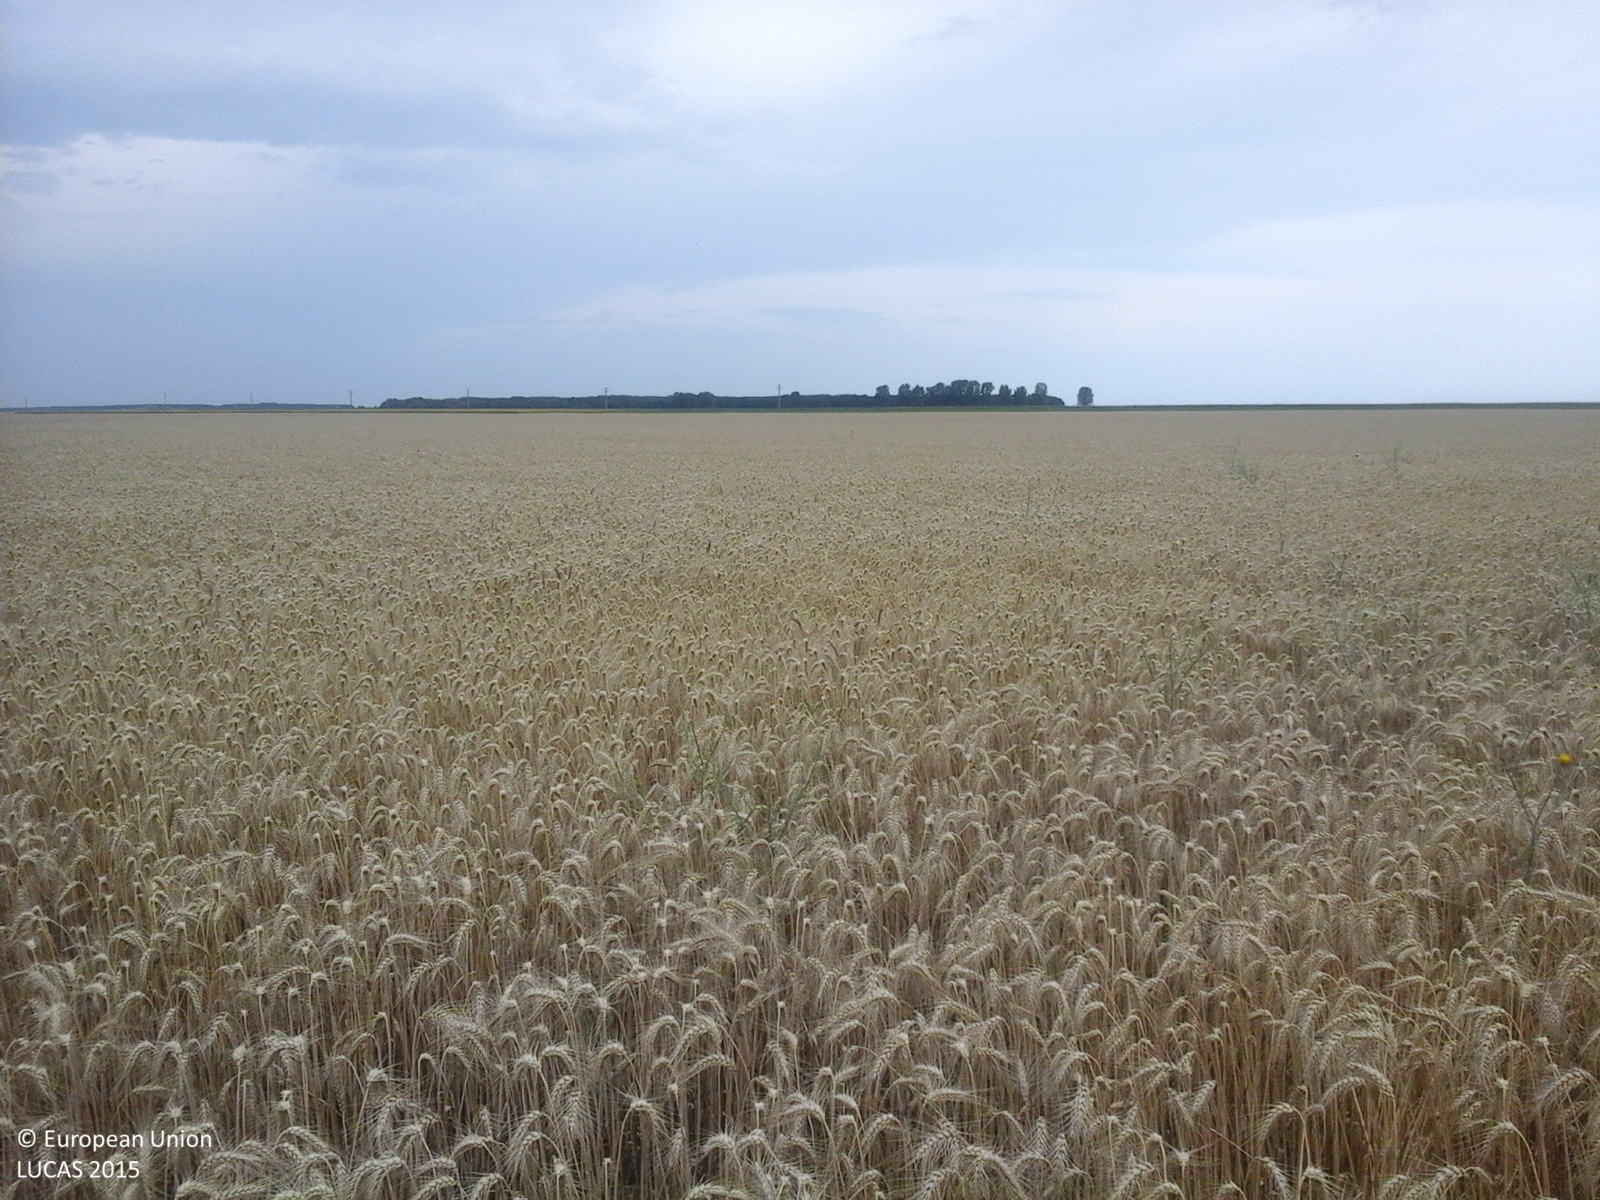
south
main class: Cropland
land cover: Common wheat
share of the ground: > 75 %
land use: Agriculture (excluding fallow land and kitchen gardens)
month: July
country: RO
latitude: 43.9678
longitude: 24.3599
